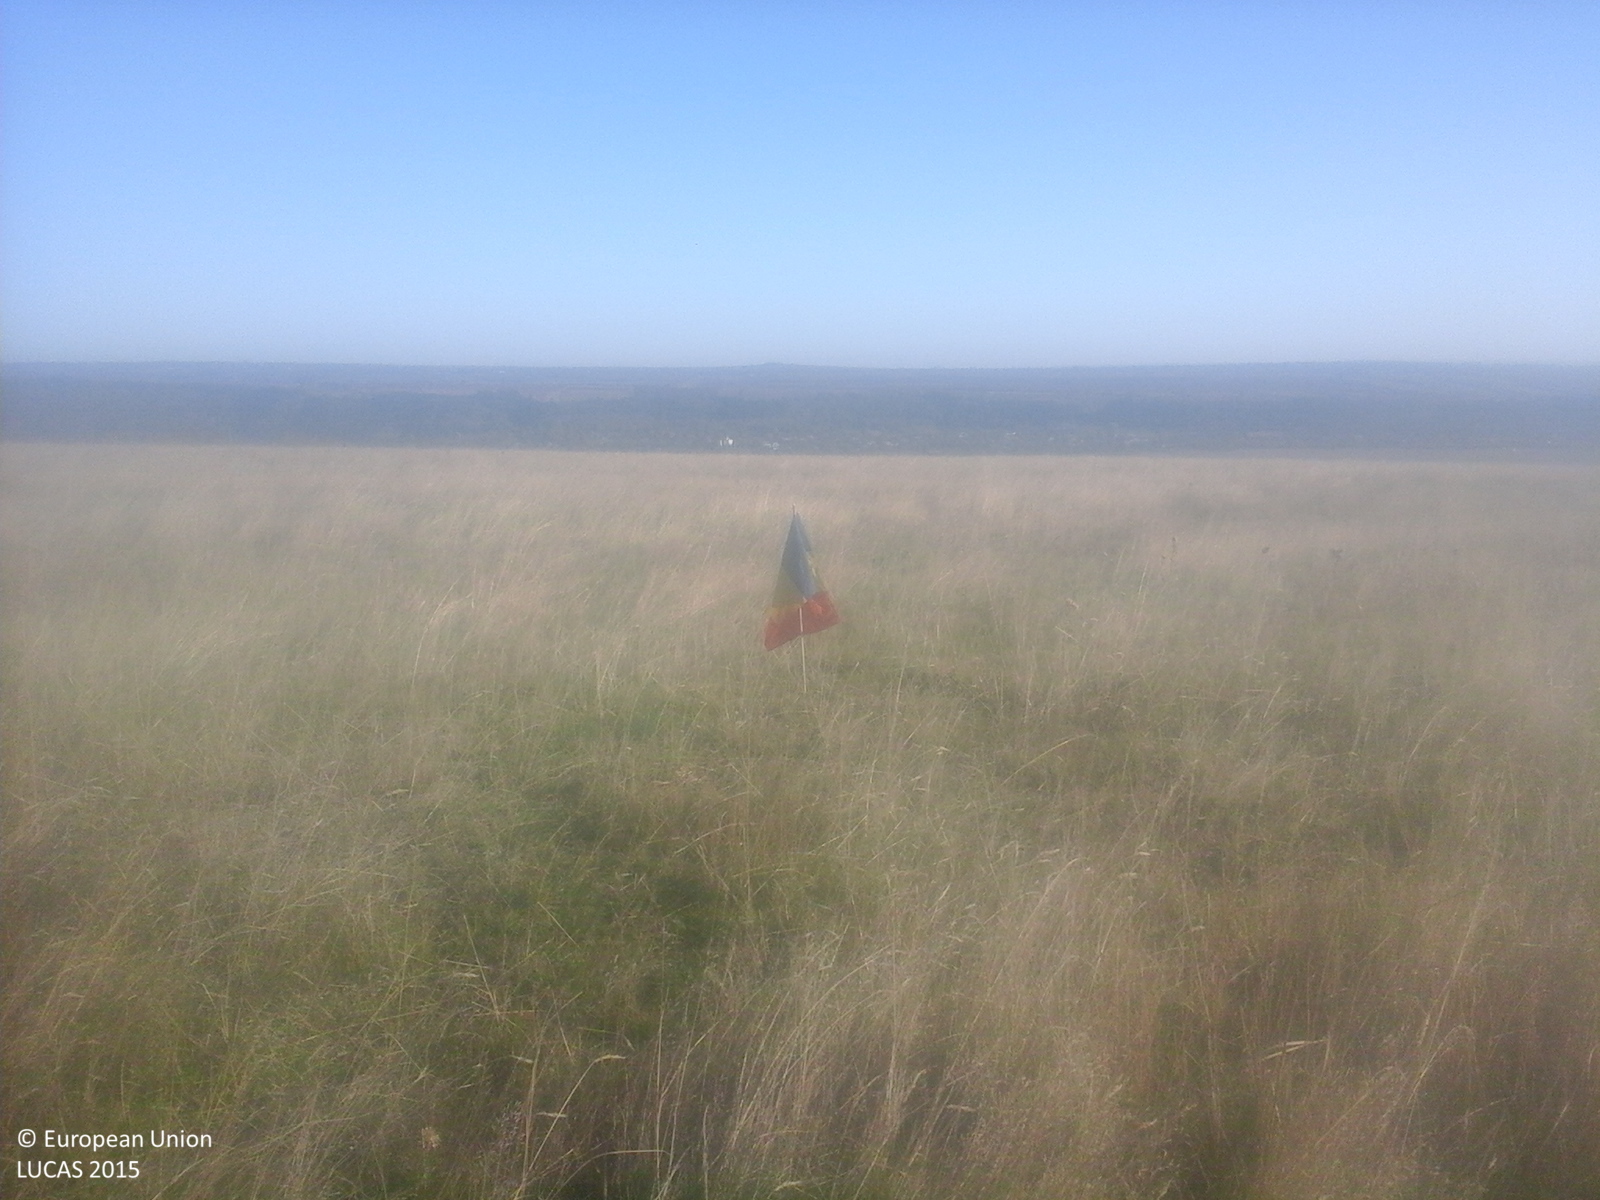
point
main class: Grassland
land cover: Grassland without tree/shrub cover
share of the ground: > 75 %
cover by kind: herbaceous plants 100 %
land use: Agriculture (excluding fallow land and kitchen gardens)
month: October
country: RO
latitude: 45.8774
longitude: 27.0080
